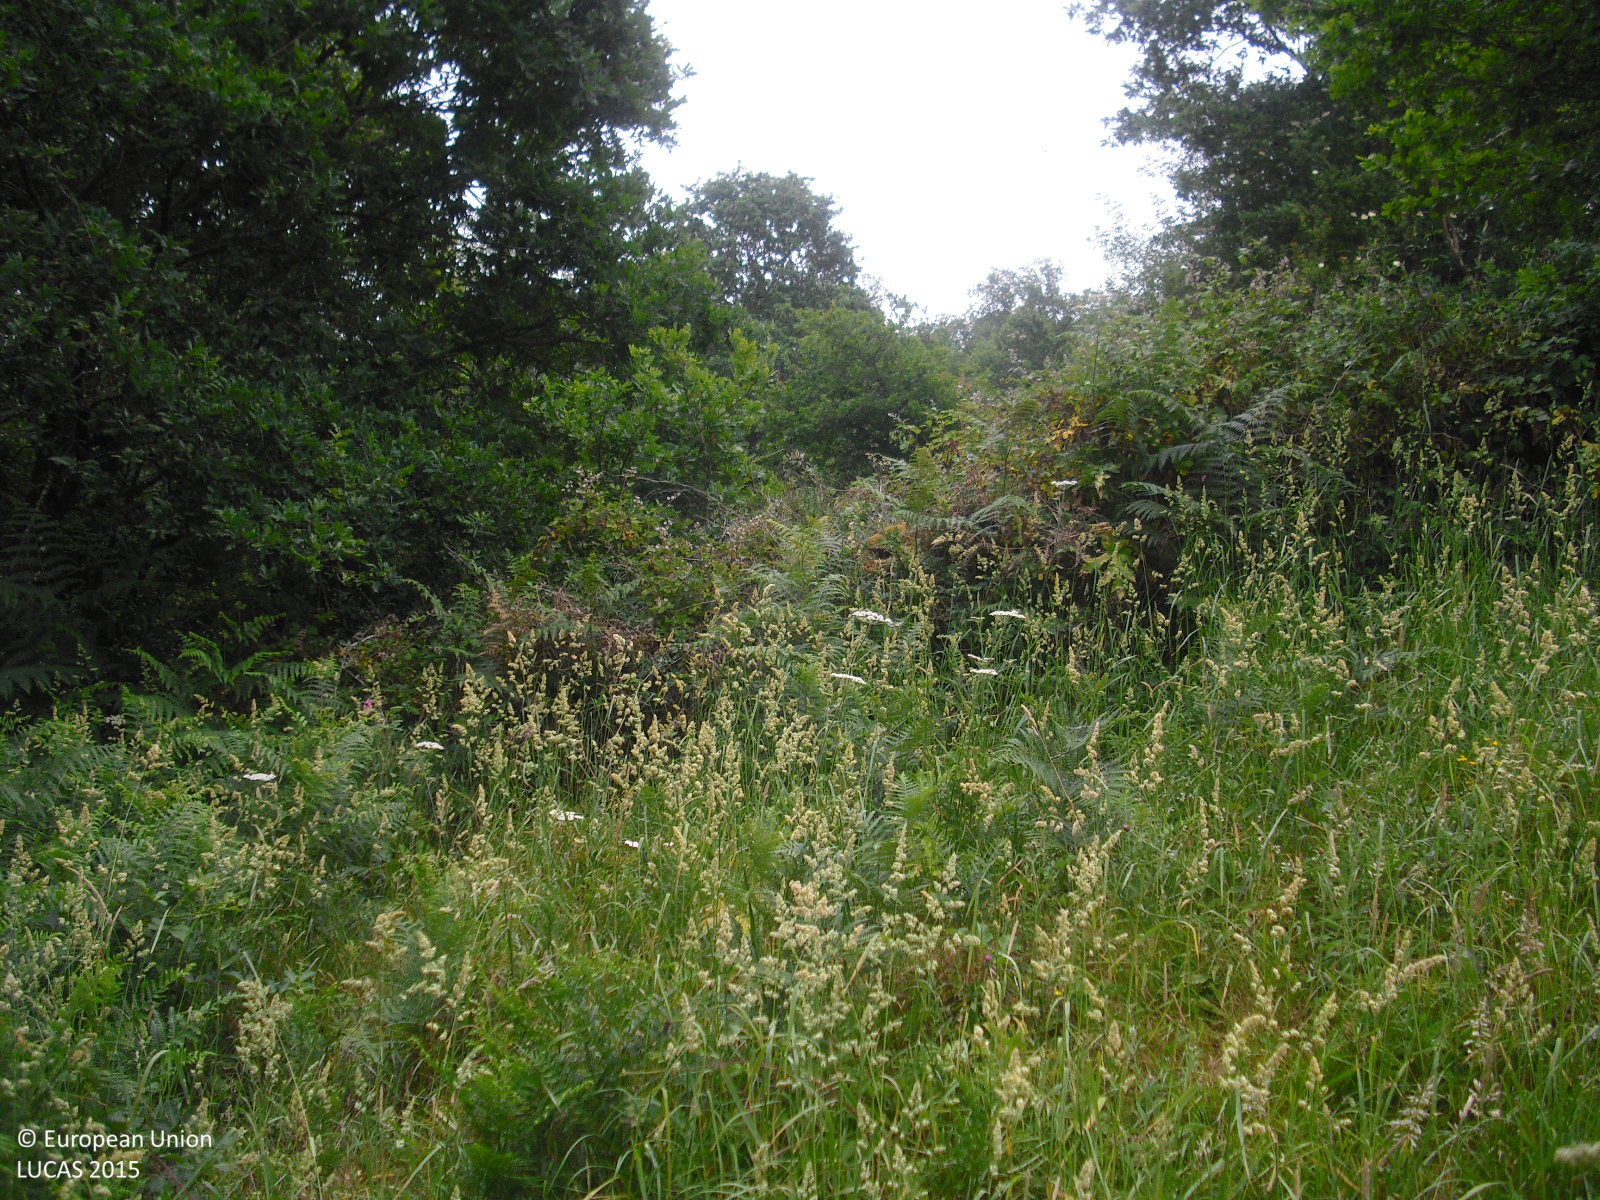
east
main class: Grassland
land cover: Grassland without tree/shrub cover
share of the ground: > 75 %
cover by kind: herbaceous plants 100 %
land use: Agriculture (excluding fallow land and kitchen gardens)
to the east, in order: Grassland without tree/shrub cover; Shruby margins; Dry stone walls; Shruby margins; Tracks; Shruby margins; Dry stone walls; Shruby margins; Grassland without tree/shrub cover; Shruby margins; Dry stone walls; Broadleaved woodland; Ditches and canals; Broadleaved woodland; Rivers and streams; Dry stone walls; Shruby margins; Grassland without tree/shrub cover; Shruby margins; Dry stone walls; Shruby margins; Grassland without tree/shrub cover; Rivers and streams; Shrubland without tree cover; Groves; Dry stone walls; Ditches and canals; Broadleaved woodland; Shrubland with sparse tree cover
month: June
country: ES
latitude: 42.7144
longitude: -7.9483
